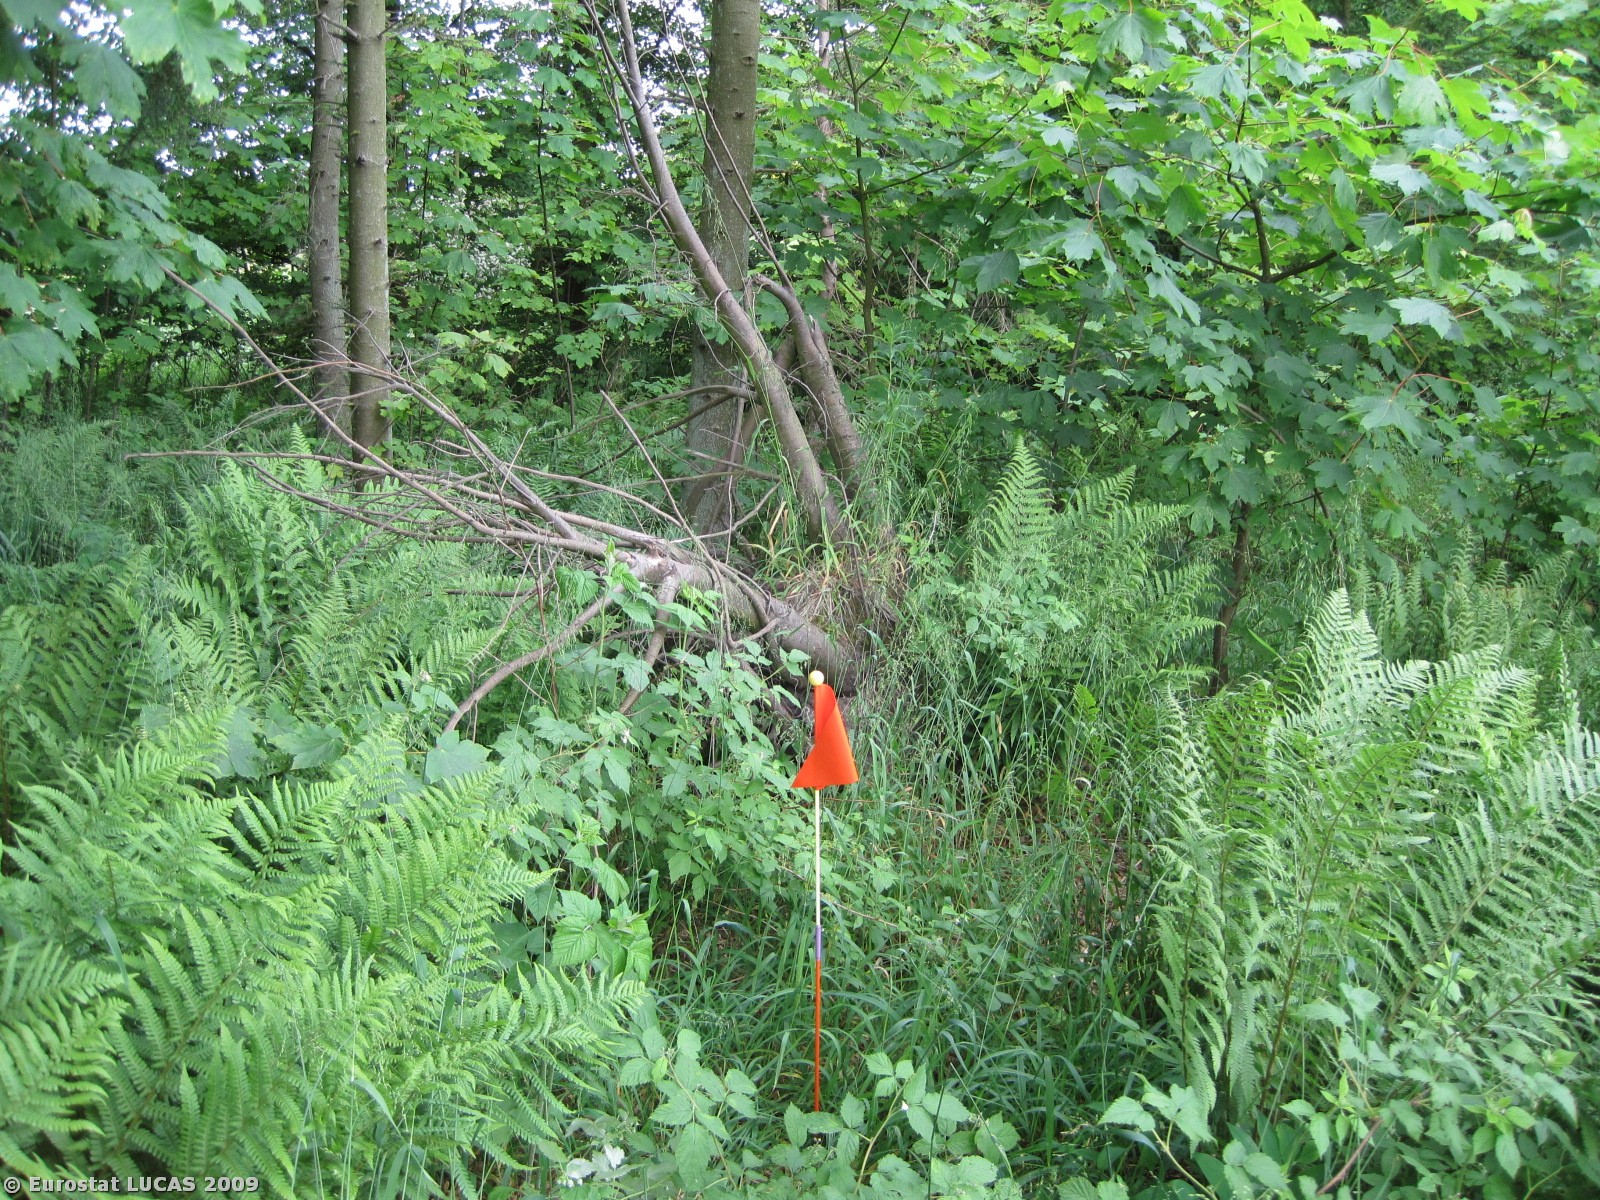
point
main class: Woodland
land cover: Mixed woodland
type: plantations and self-sown exotic forest
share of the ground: 50 - 75 %
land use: Agriculture (excluding fallow land and kitchen gardens)
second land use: Amenities, museums, leisure
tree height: > 5 m
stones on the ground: < 10 %
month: June
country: DK
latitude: 57.0865
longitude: 10.1483
